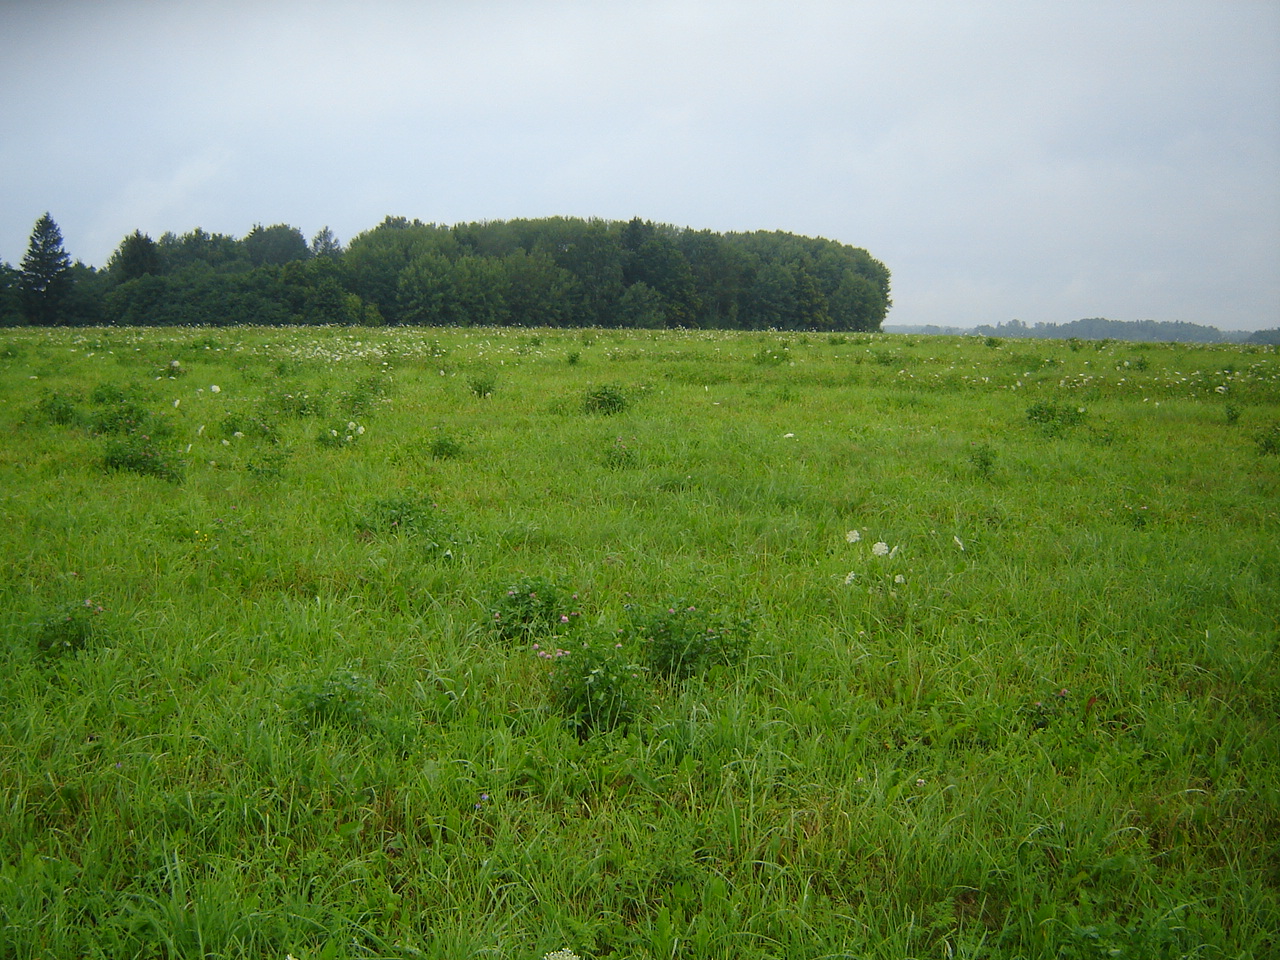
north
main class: Grassland
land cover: Grassland without tree/shrub cover
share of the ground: > 75 %
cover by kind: herbaceous plants 100 %
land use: Agriculture (excluding fallow land and kitchen gardens)
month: July
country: LT
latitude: 55.4355
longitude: 25.0812
